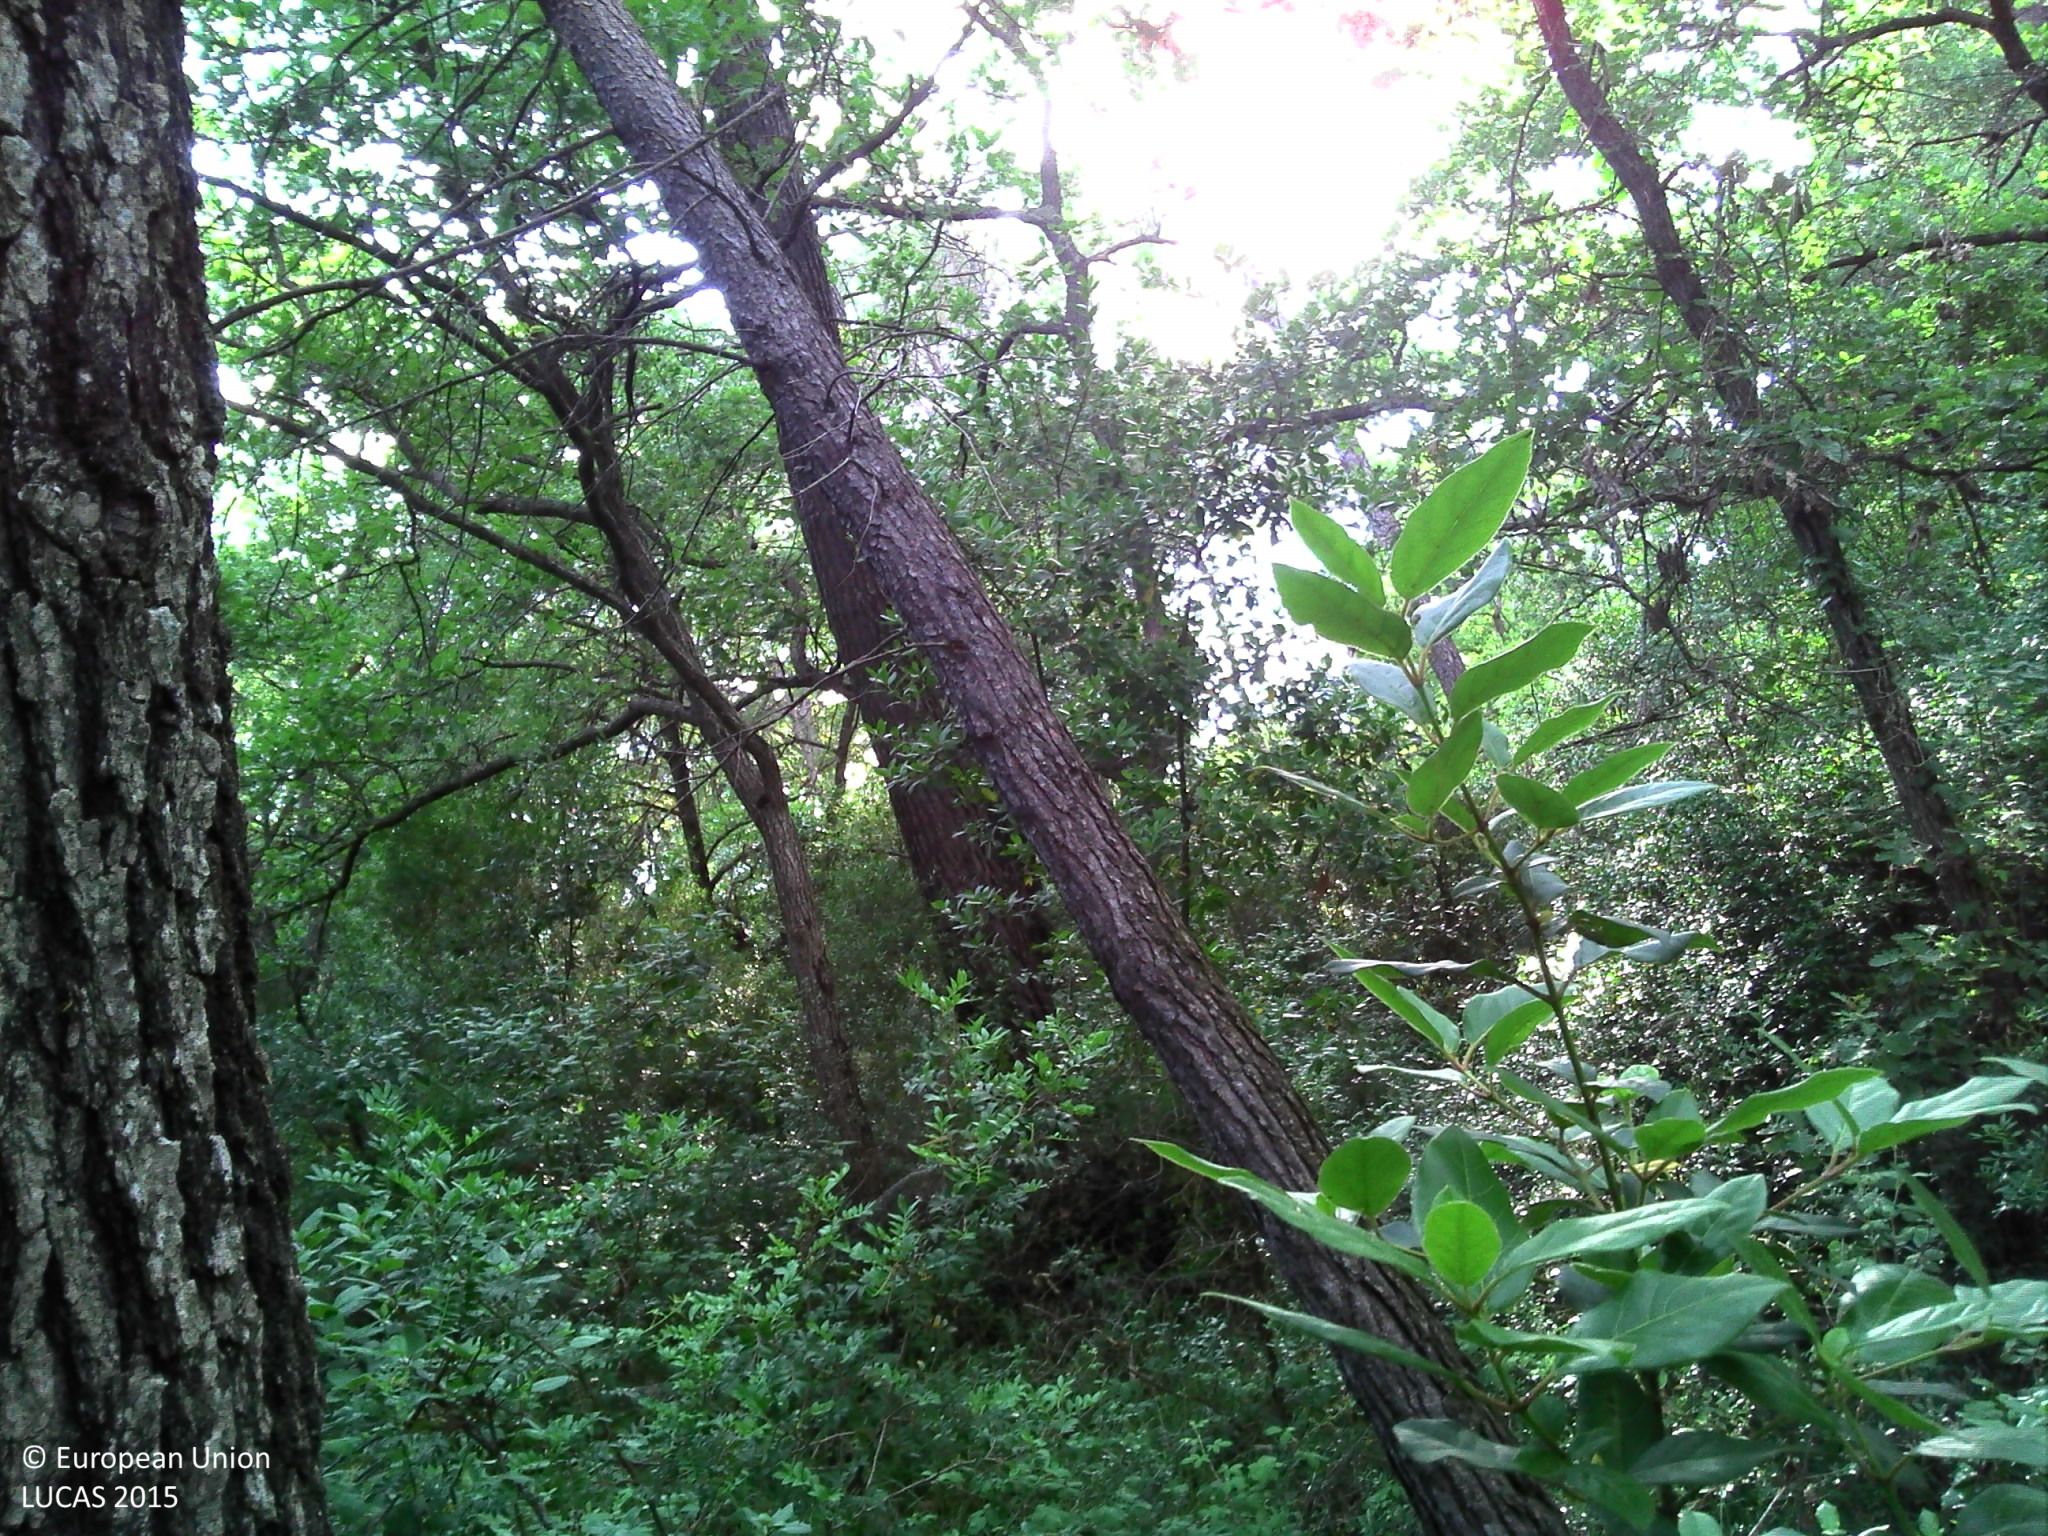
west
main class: Woodland
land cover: Pine dominated mixed woodland
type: thermophilous deciduous forest
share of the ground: > 75 %
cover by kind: broadleaved forest trees 45 %, coniferous forest trees 35 %, shrubs 15 %, herbaceous plants 5 %
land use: Forestry
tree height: > 5 m
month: June
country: FR
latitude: 43.6399
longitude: 7.0198
